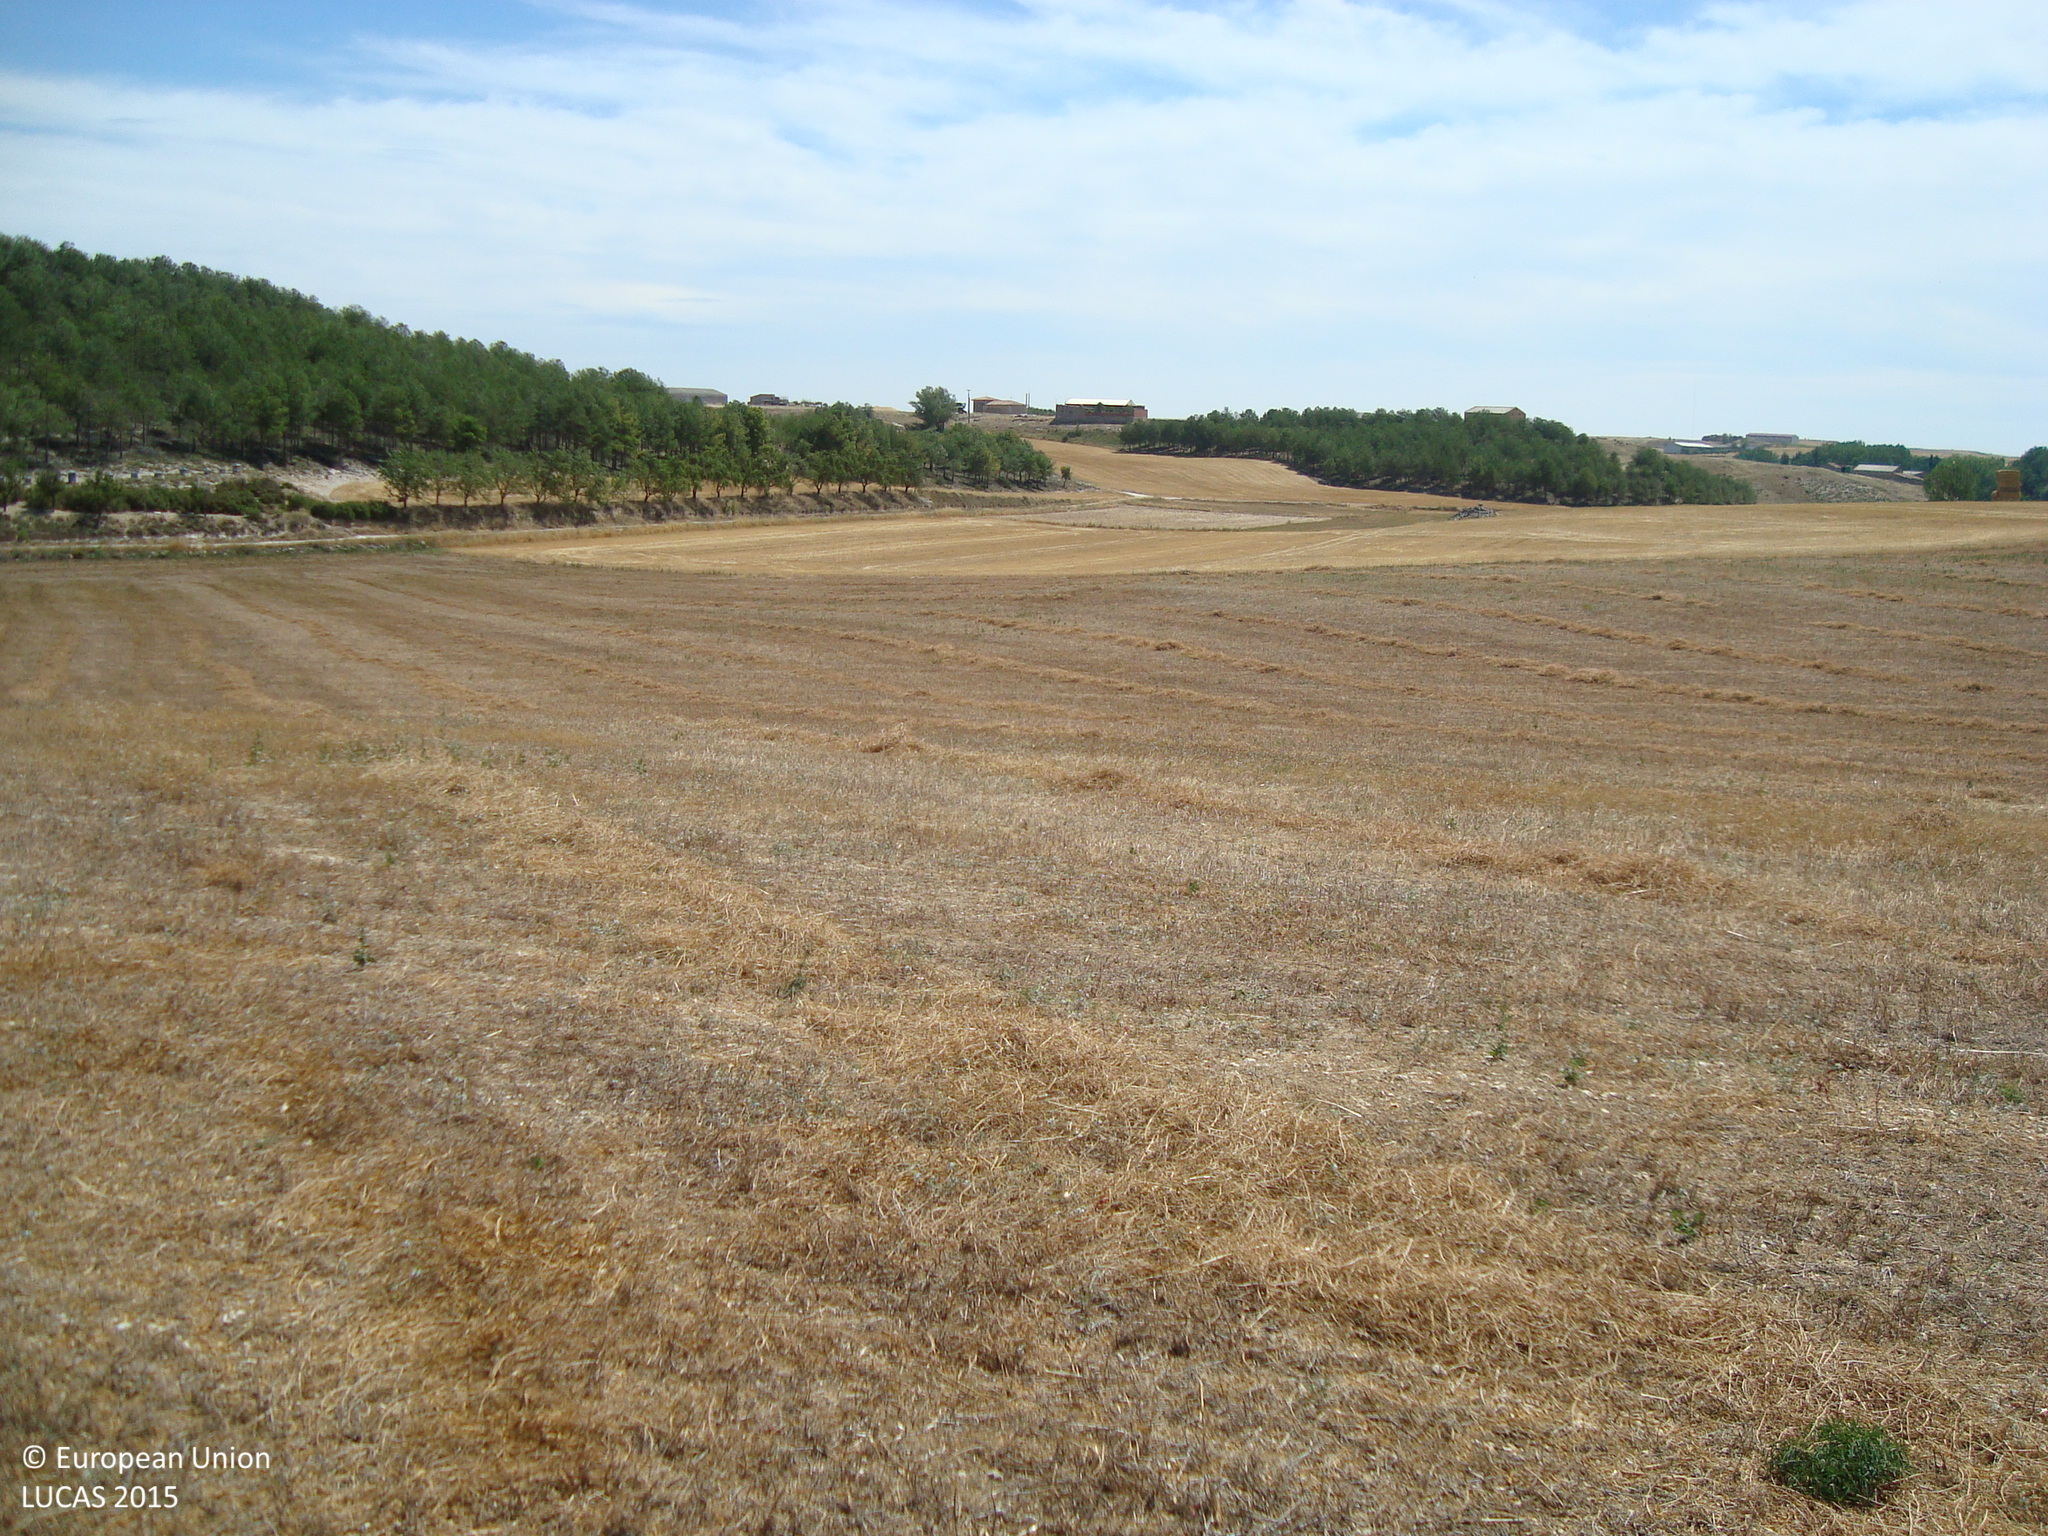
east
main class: Cropland
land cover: Dry pulses
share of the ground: > 75 %
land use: Agriculture (excluding fallow land and kitchen gardens)
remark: Harvested field
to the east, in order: Dry pulses; Barley
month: July
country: ES
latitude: 41.8862
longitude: -3.8076
